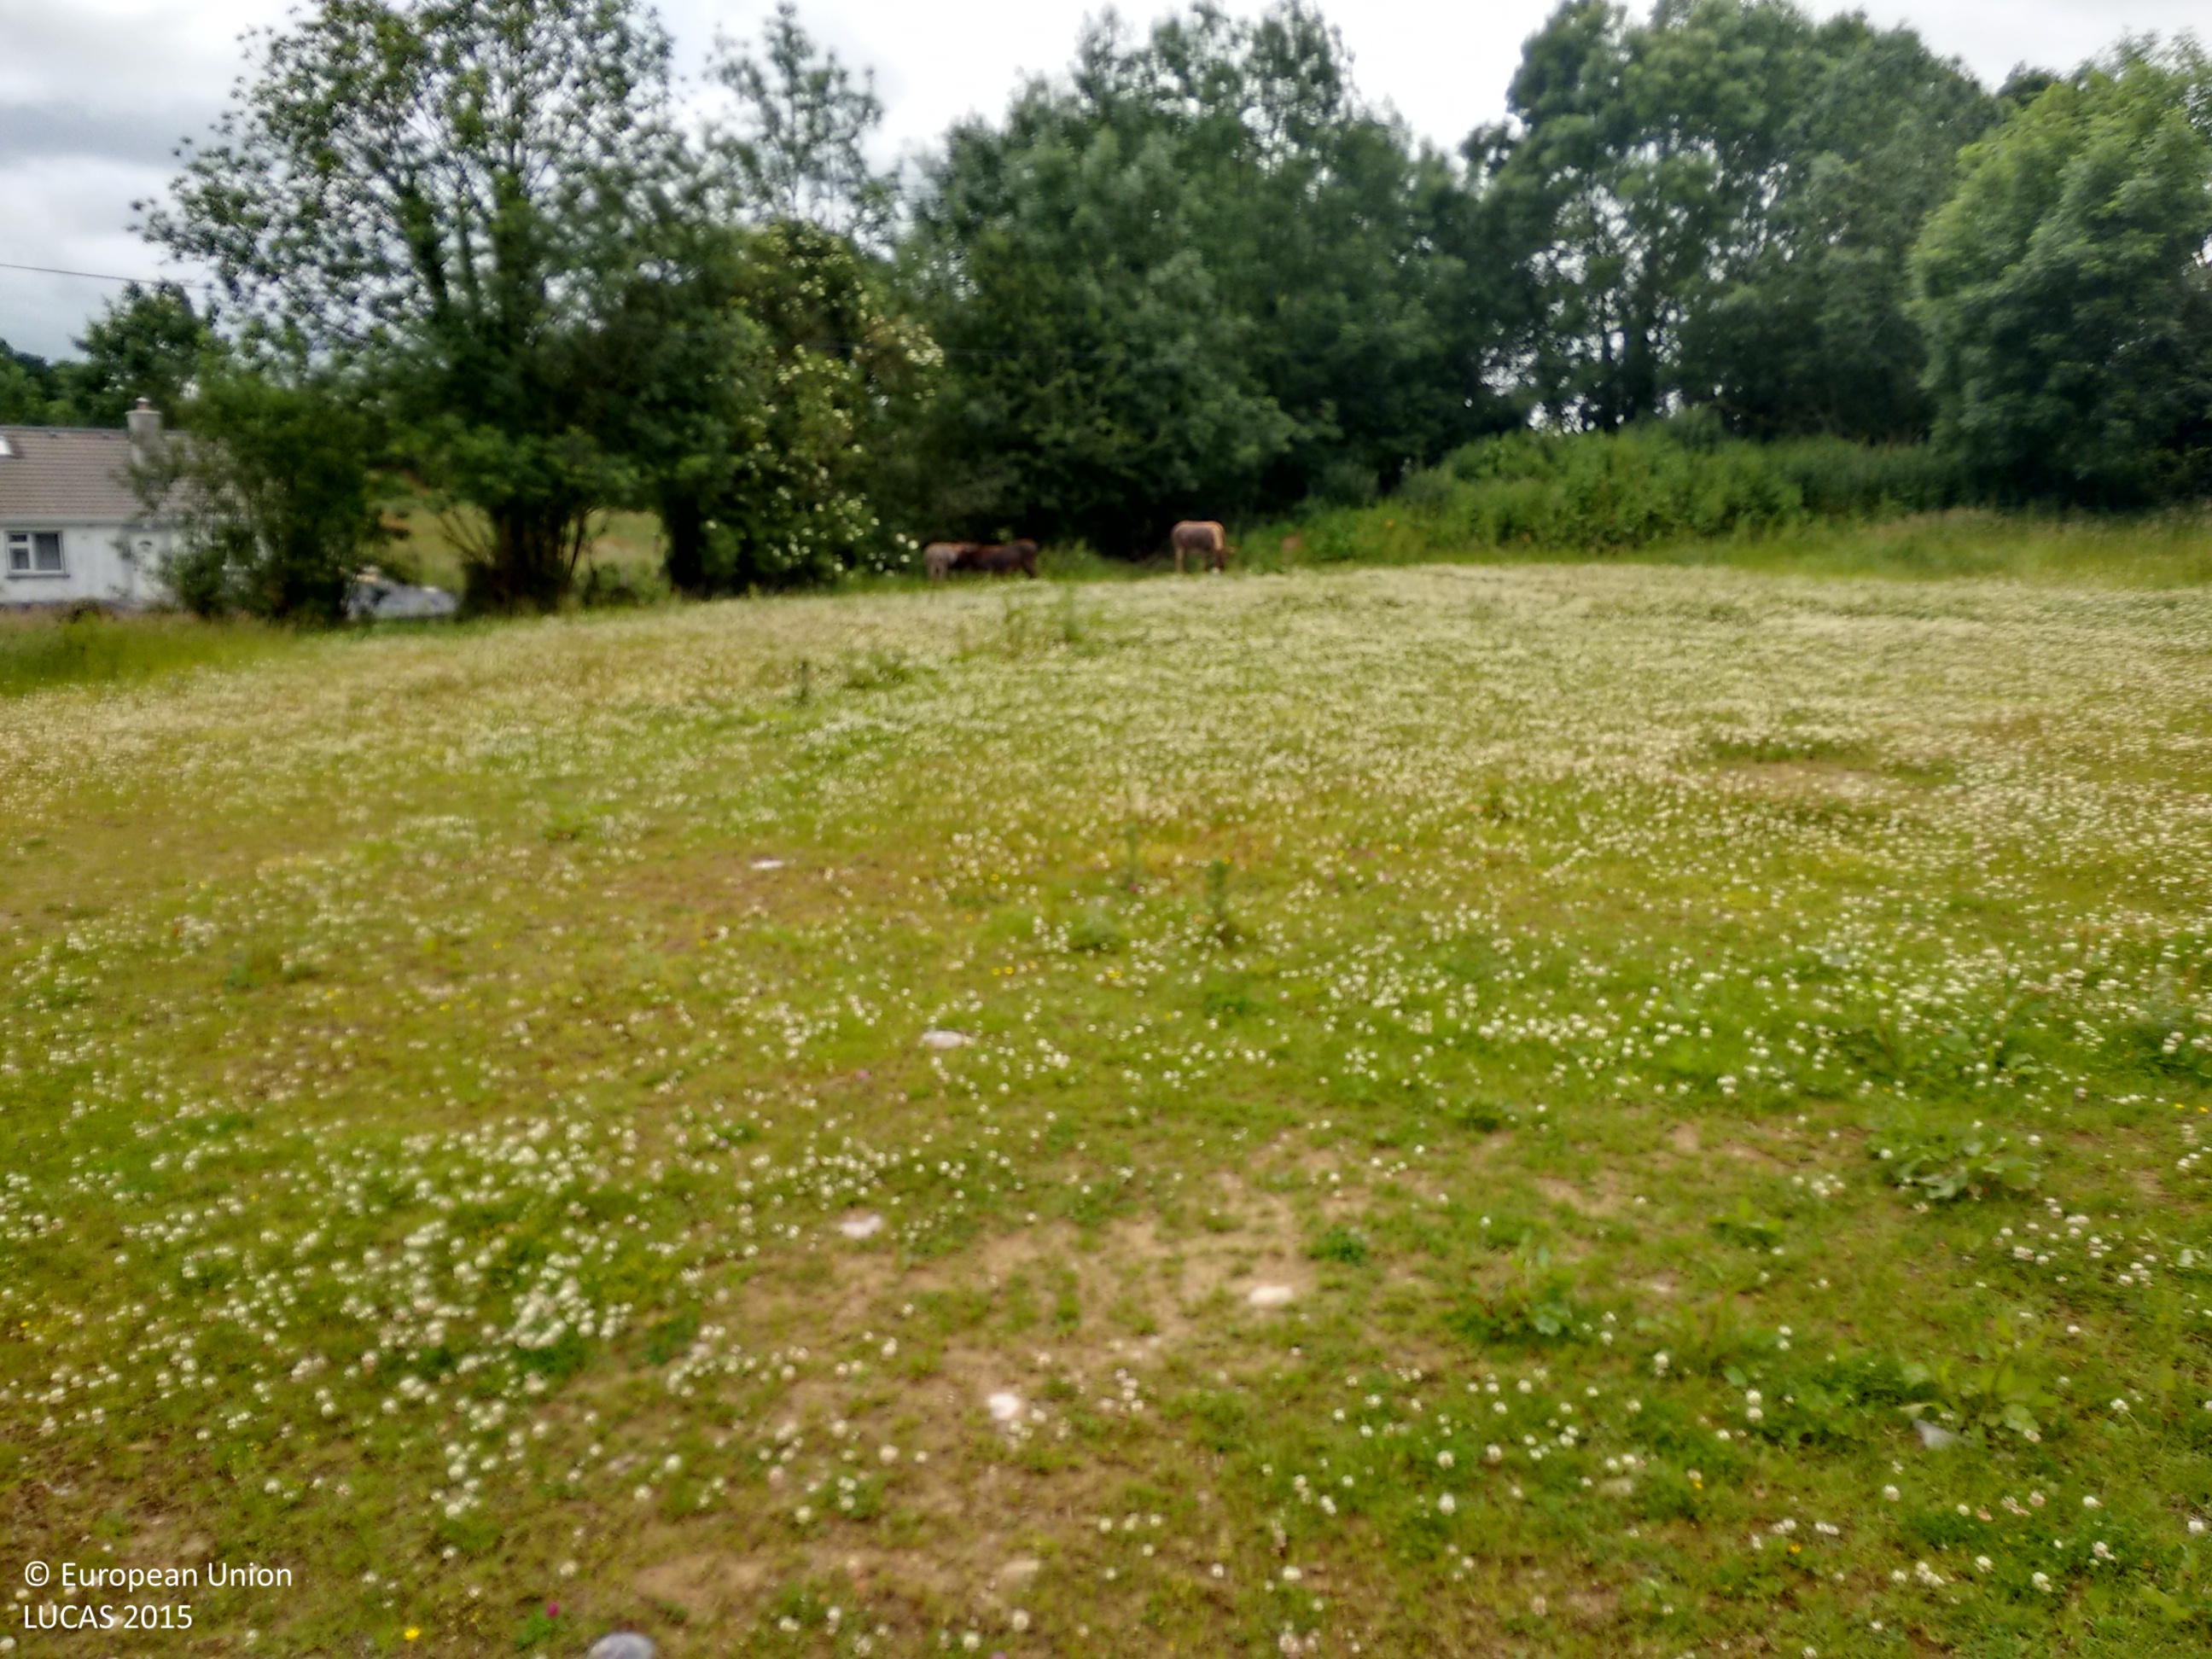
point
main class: Grassland
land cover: Grassland without tree/shrub cover
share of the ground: > 75 %
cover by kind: herbaceous plants 100 %
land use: Agriculture (excluding fallow land and kitchen gardens)
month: June
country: IE
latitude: 53.4368
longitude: -8.0136
